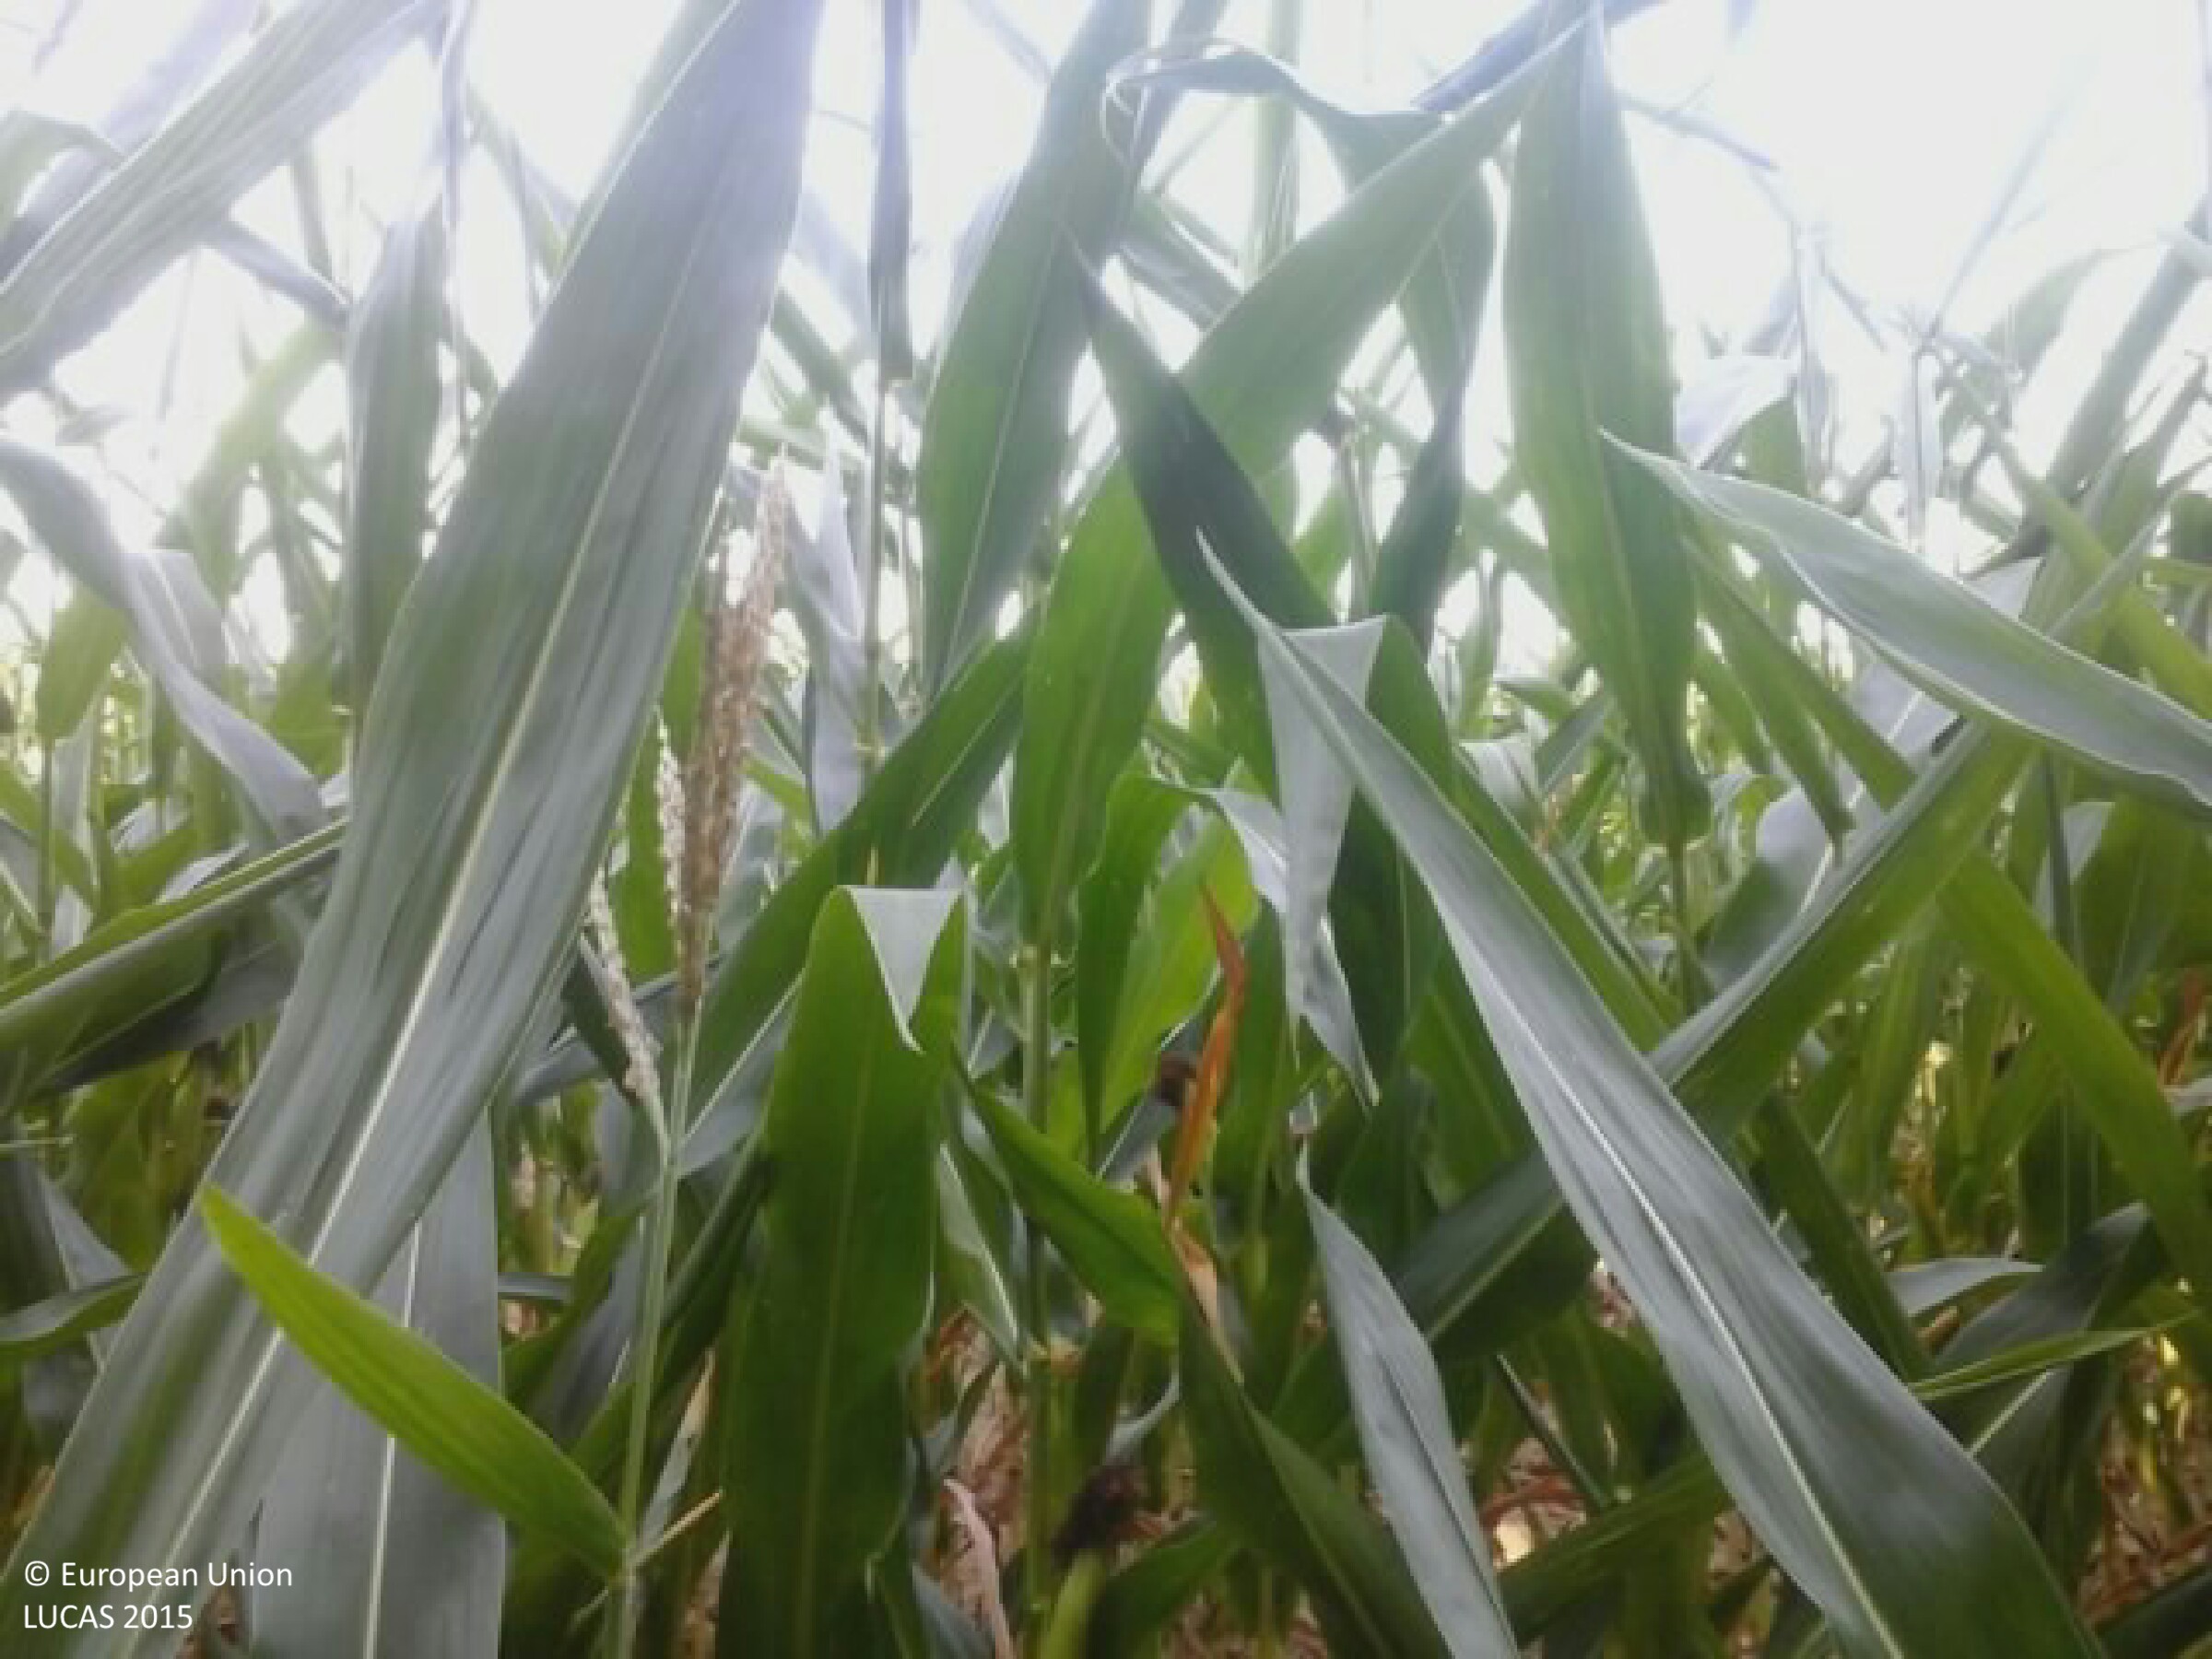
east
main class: Cropland
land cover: Maize
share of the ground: > 75 %
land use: Agriculture (excluding fallow land and kitchen gardens)
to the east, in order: Maize; Tracks; Grassland without tree/shrub cover; Artificial constructions in urban areas; Arable land (only in case pi)
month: July
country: HU
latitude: 46.2223
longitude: 17.1199
